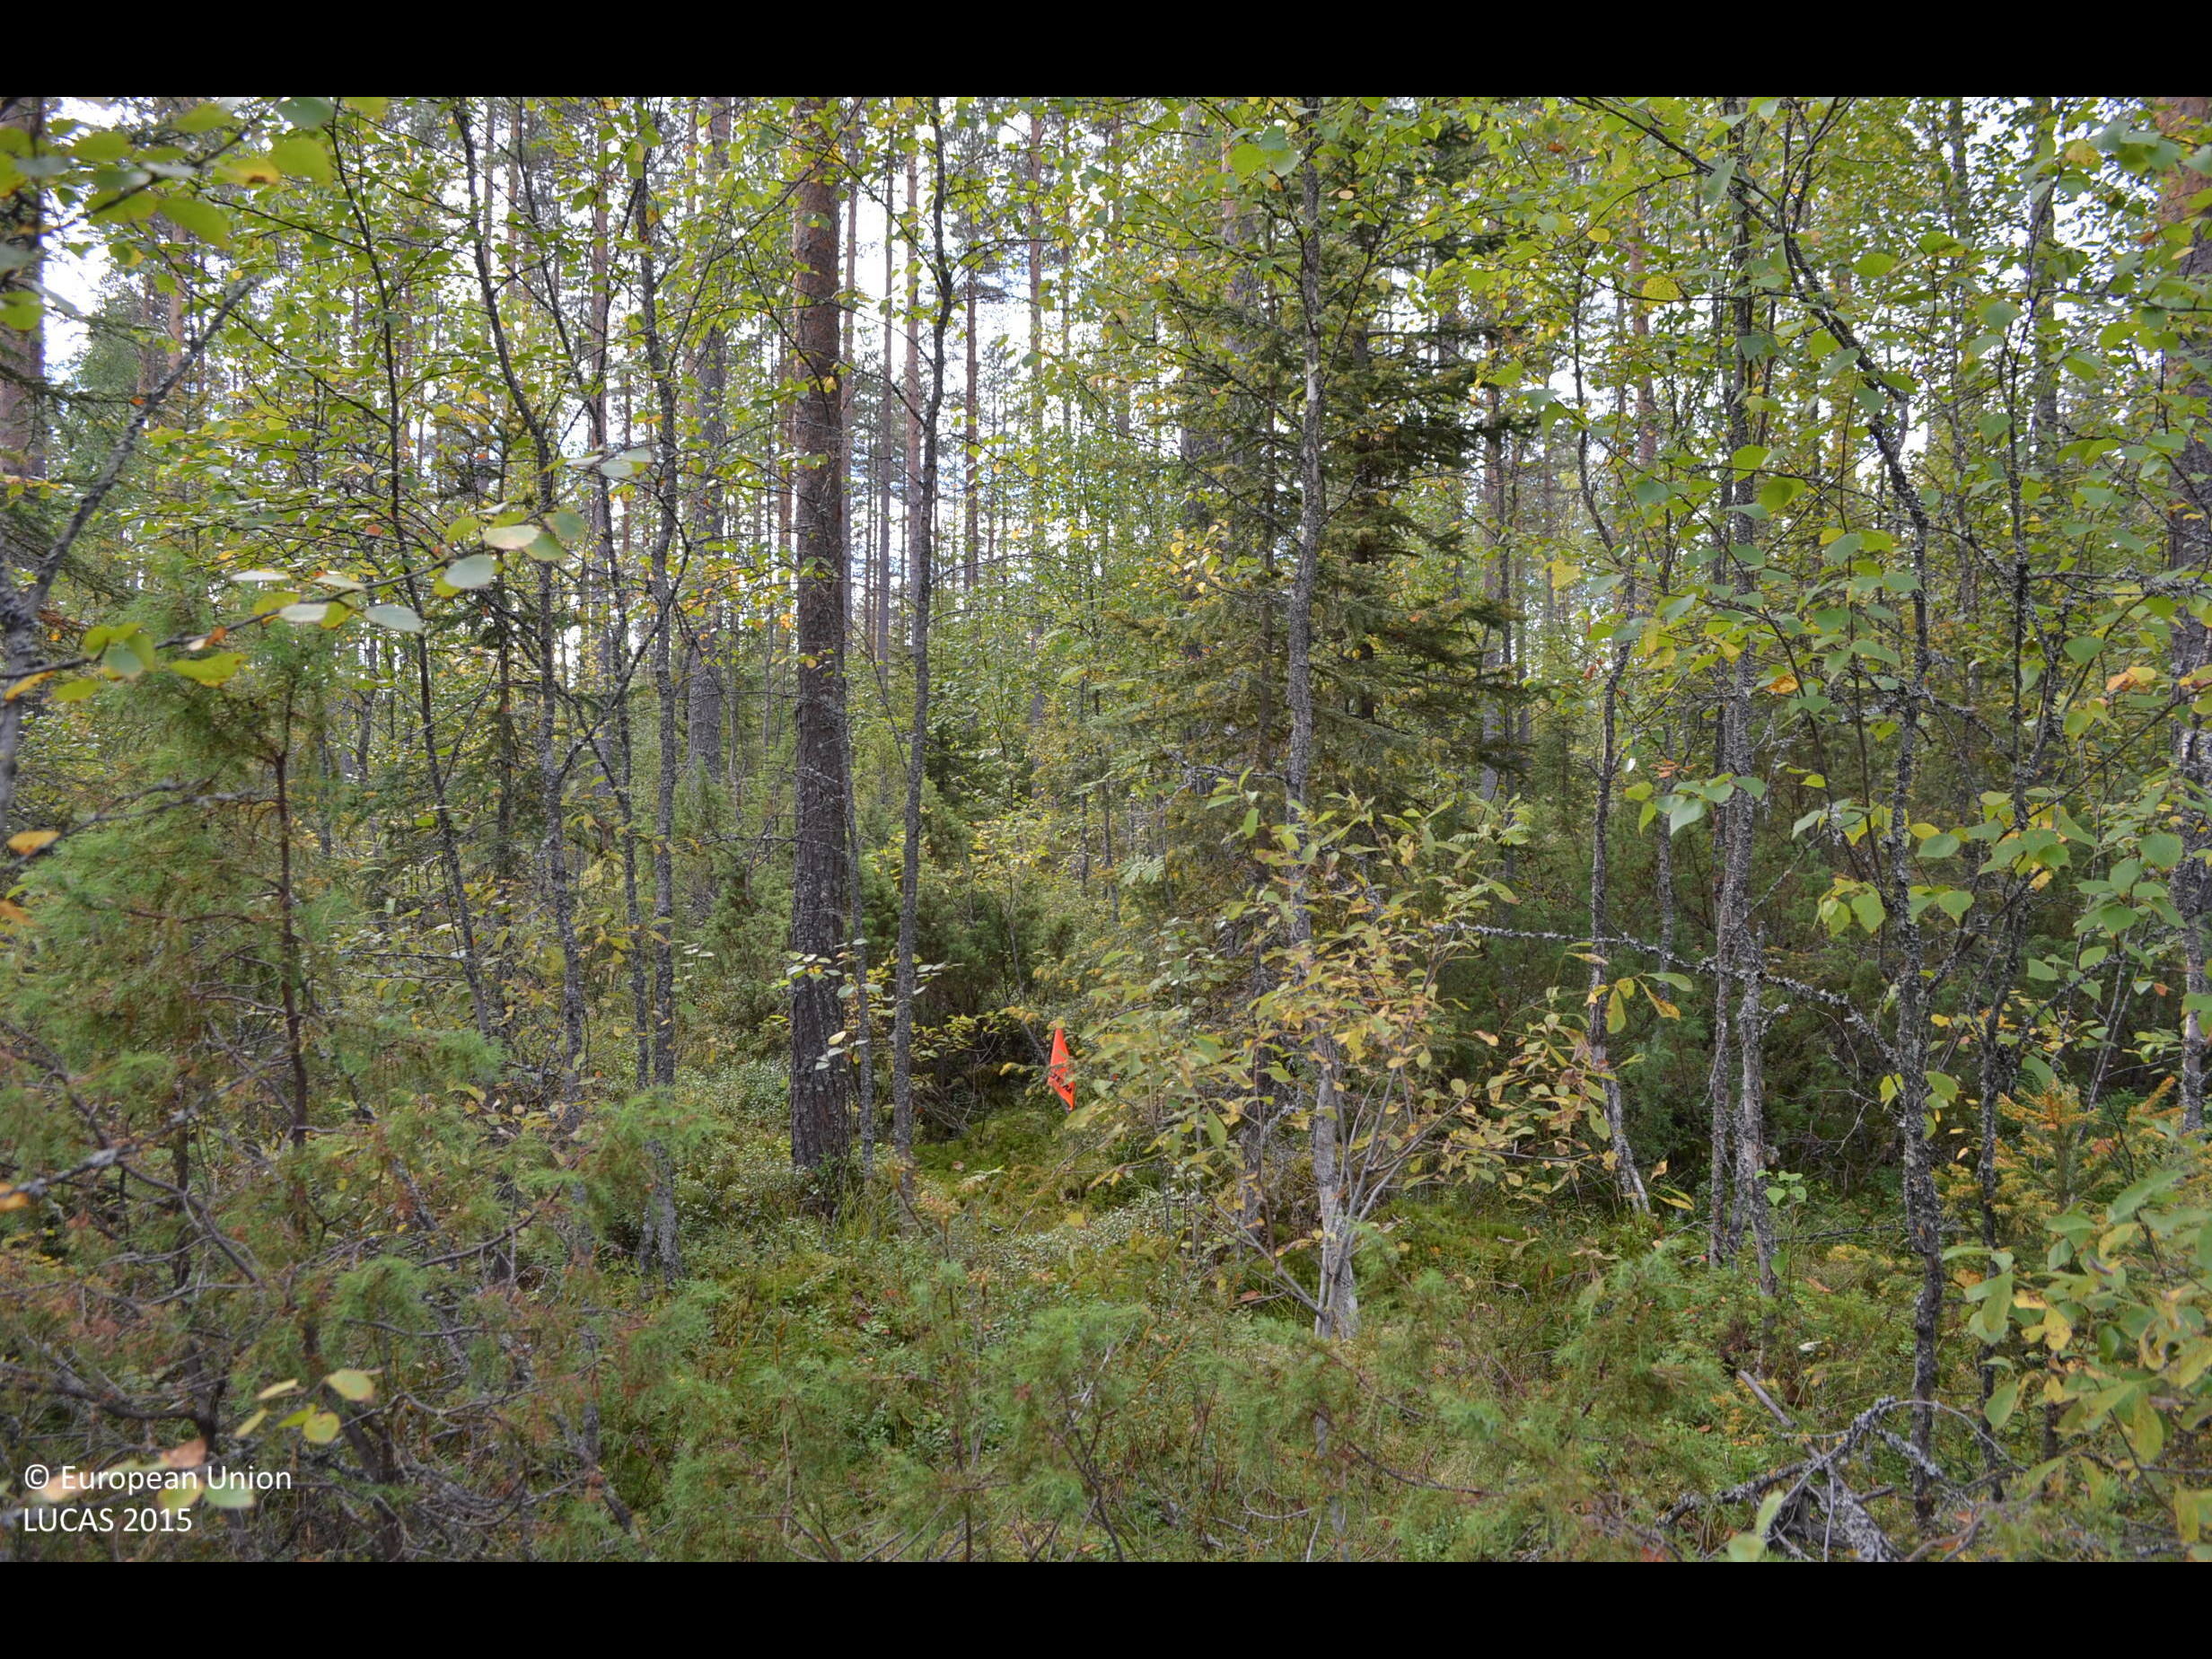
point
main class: Woodland
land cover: Pine dominated mixed woodland
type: boreal forest
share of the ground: > 75 %
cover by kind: coniferous forest trees 55 %, broadleaved forest trees 20 %, shrubs 20 %, lichens and mosses 5 %
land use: Forestry
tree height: > 5 m
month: September
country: FI
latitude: 62.6694
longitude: 24.3966
